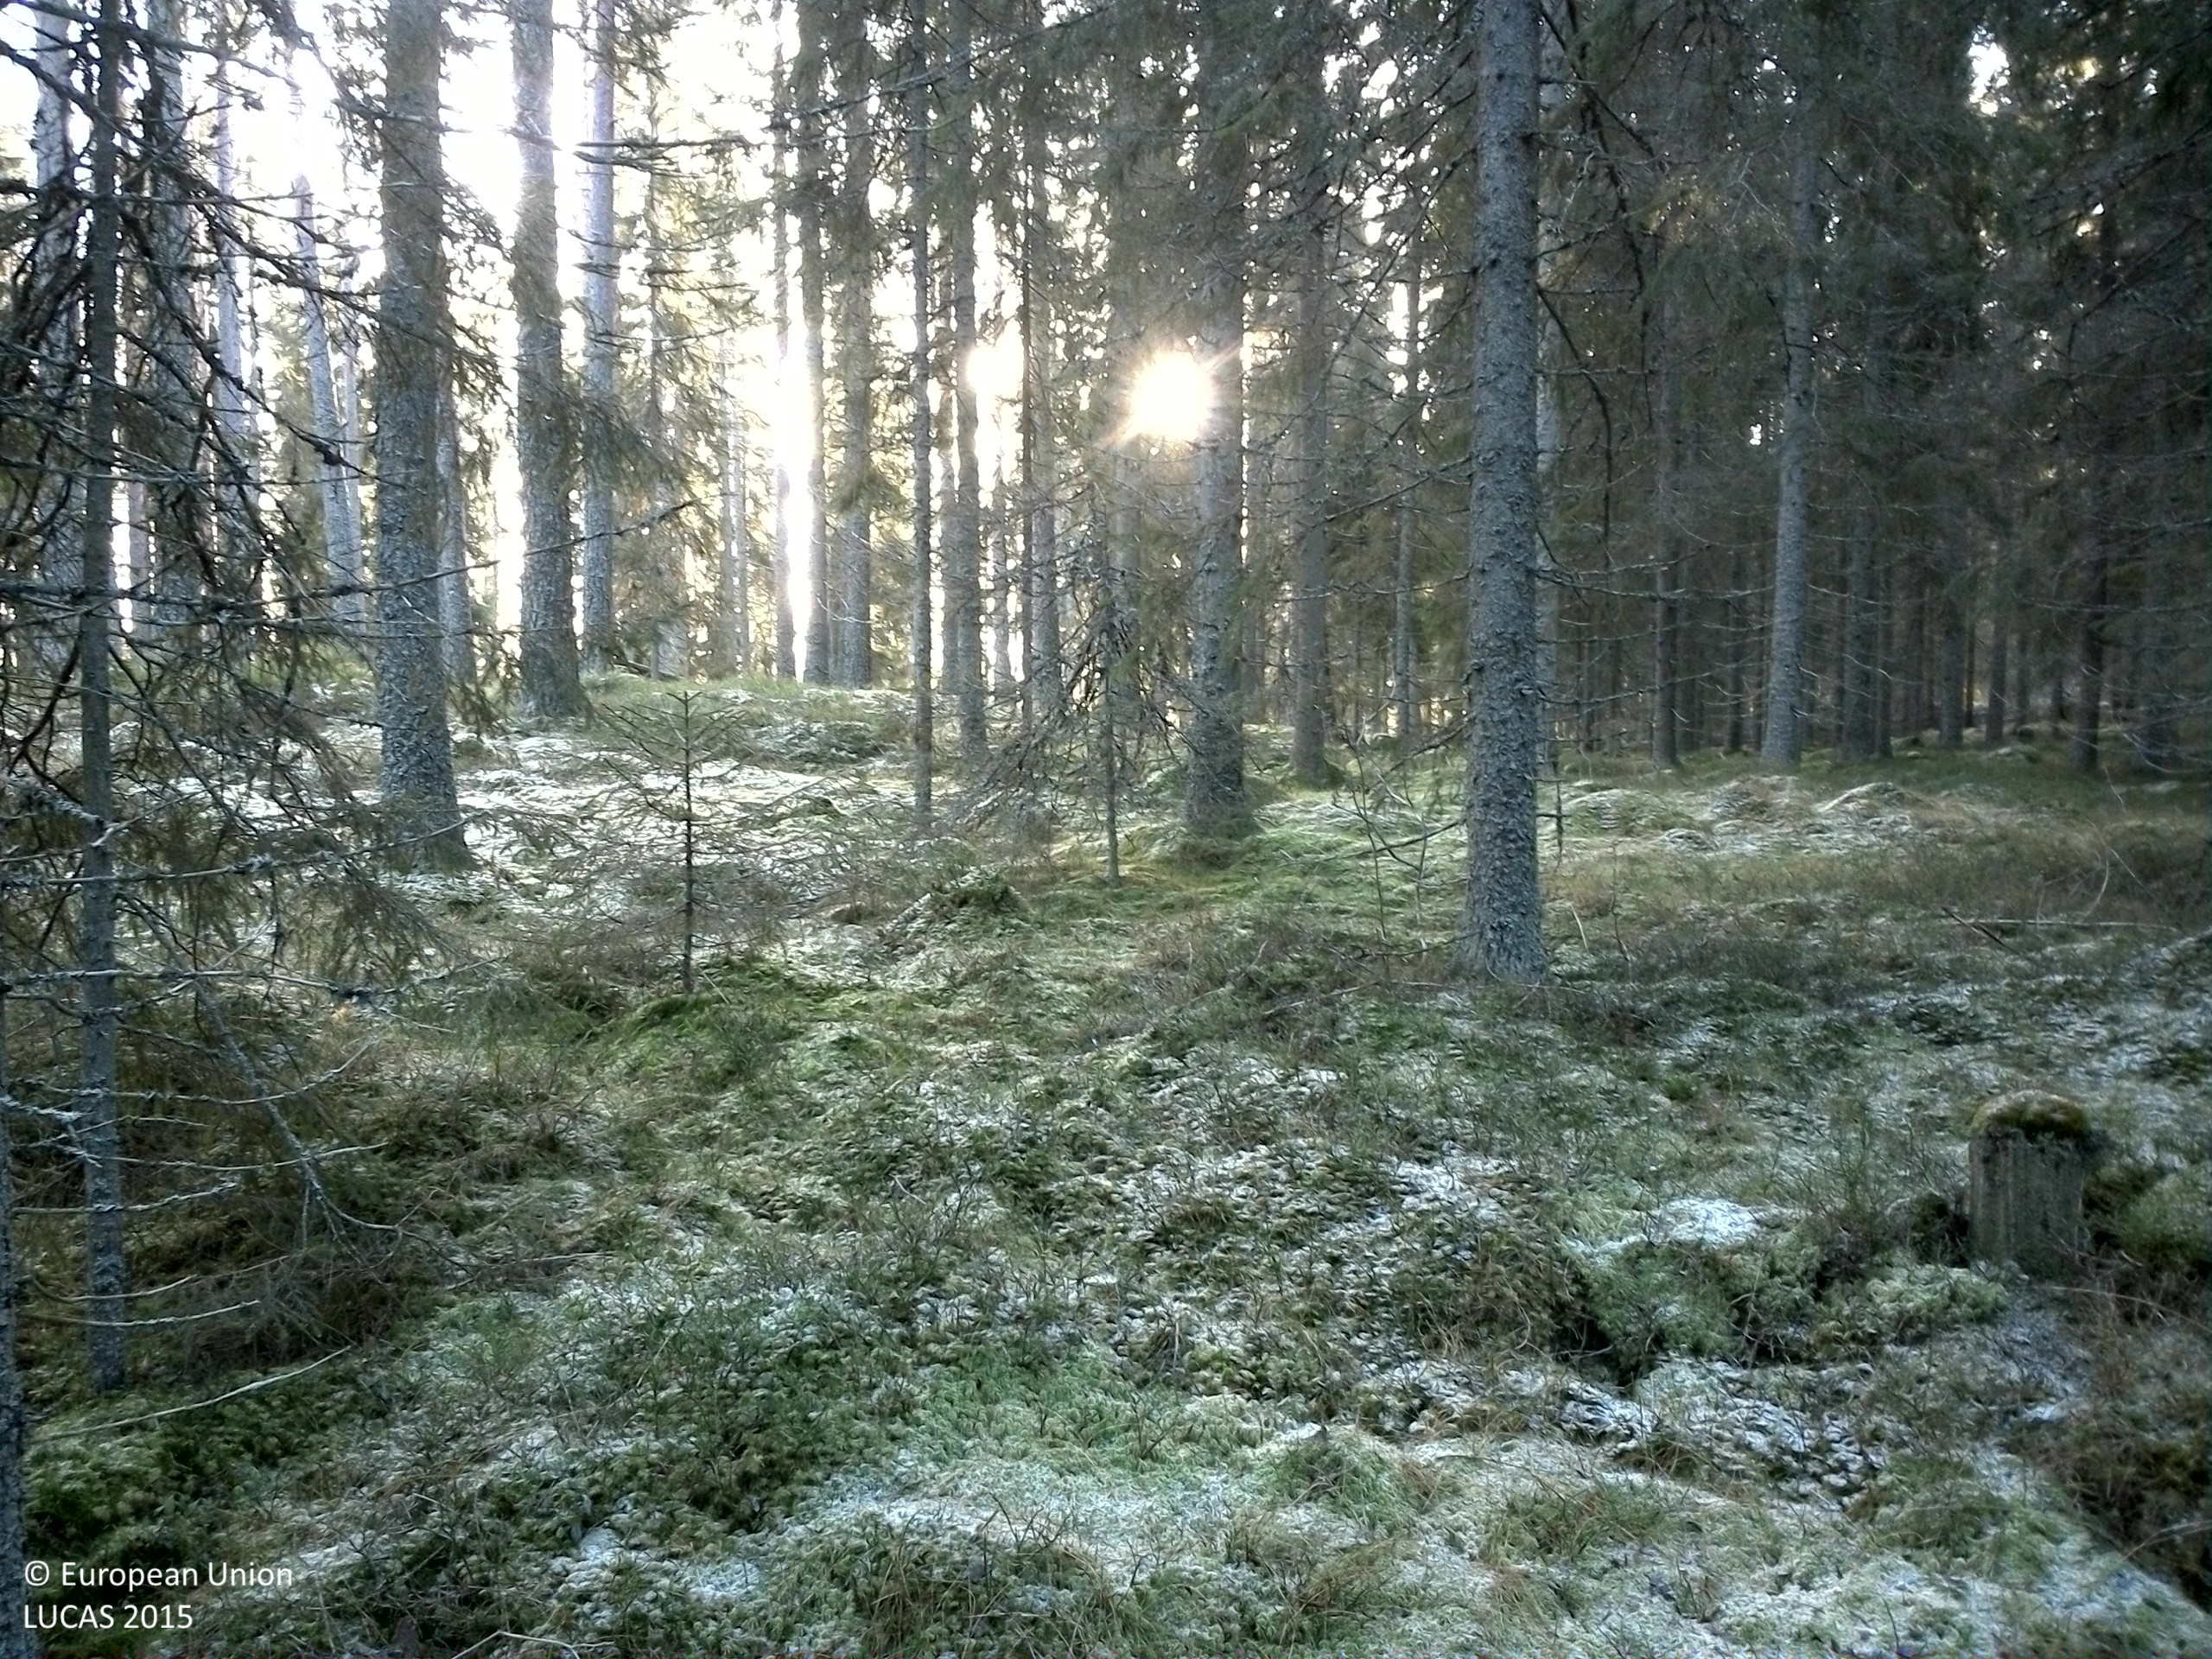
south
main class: Woodland
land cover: Spruce dominated coniferous woodland
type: boreal forest
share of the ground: > 75 %
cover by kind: coniferous forest trees 75 %, shrubs 15 %, lichens and mosses 10 %
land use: Forestry
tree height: > 5 m
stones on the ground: 10 - 25 %
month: November
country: SE
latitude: 60.3007
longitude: 15.6883
